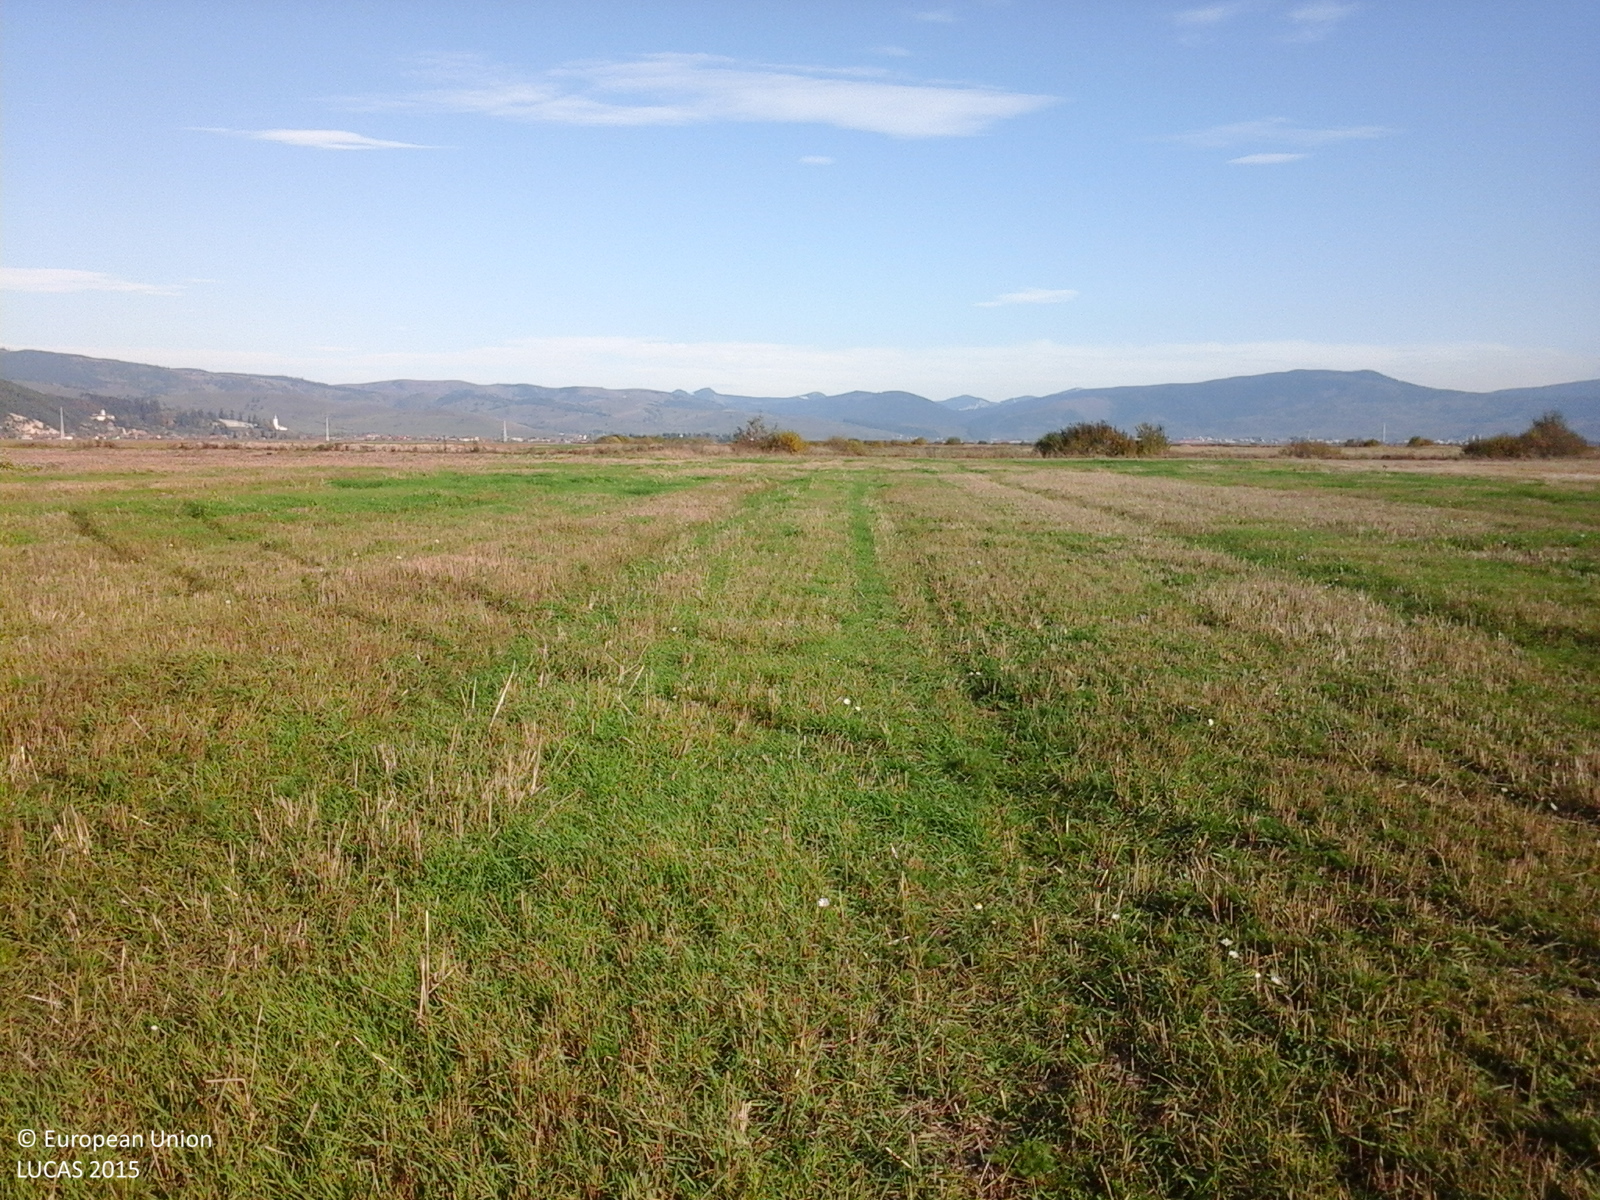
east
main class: Cropland
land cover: Durum wheat
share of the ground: 50 - 75 %
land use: Agriculture (excluding fallow land and kitchen gardens)
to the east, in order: Durum wheat; Shruby margins; Ditches and canals; Shruby margins; Tracks; Durum wheat
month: October
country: RO
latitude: 46.7356
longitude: 25.4873
